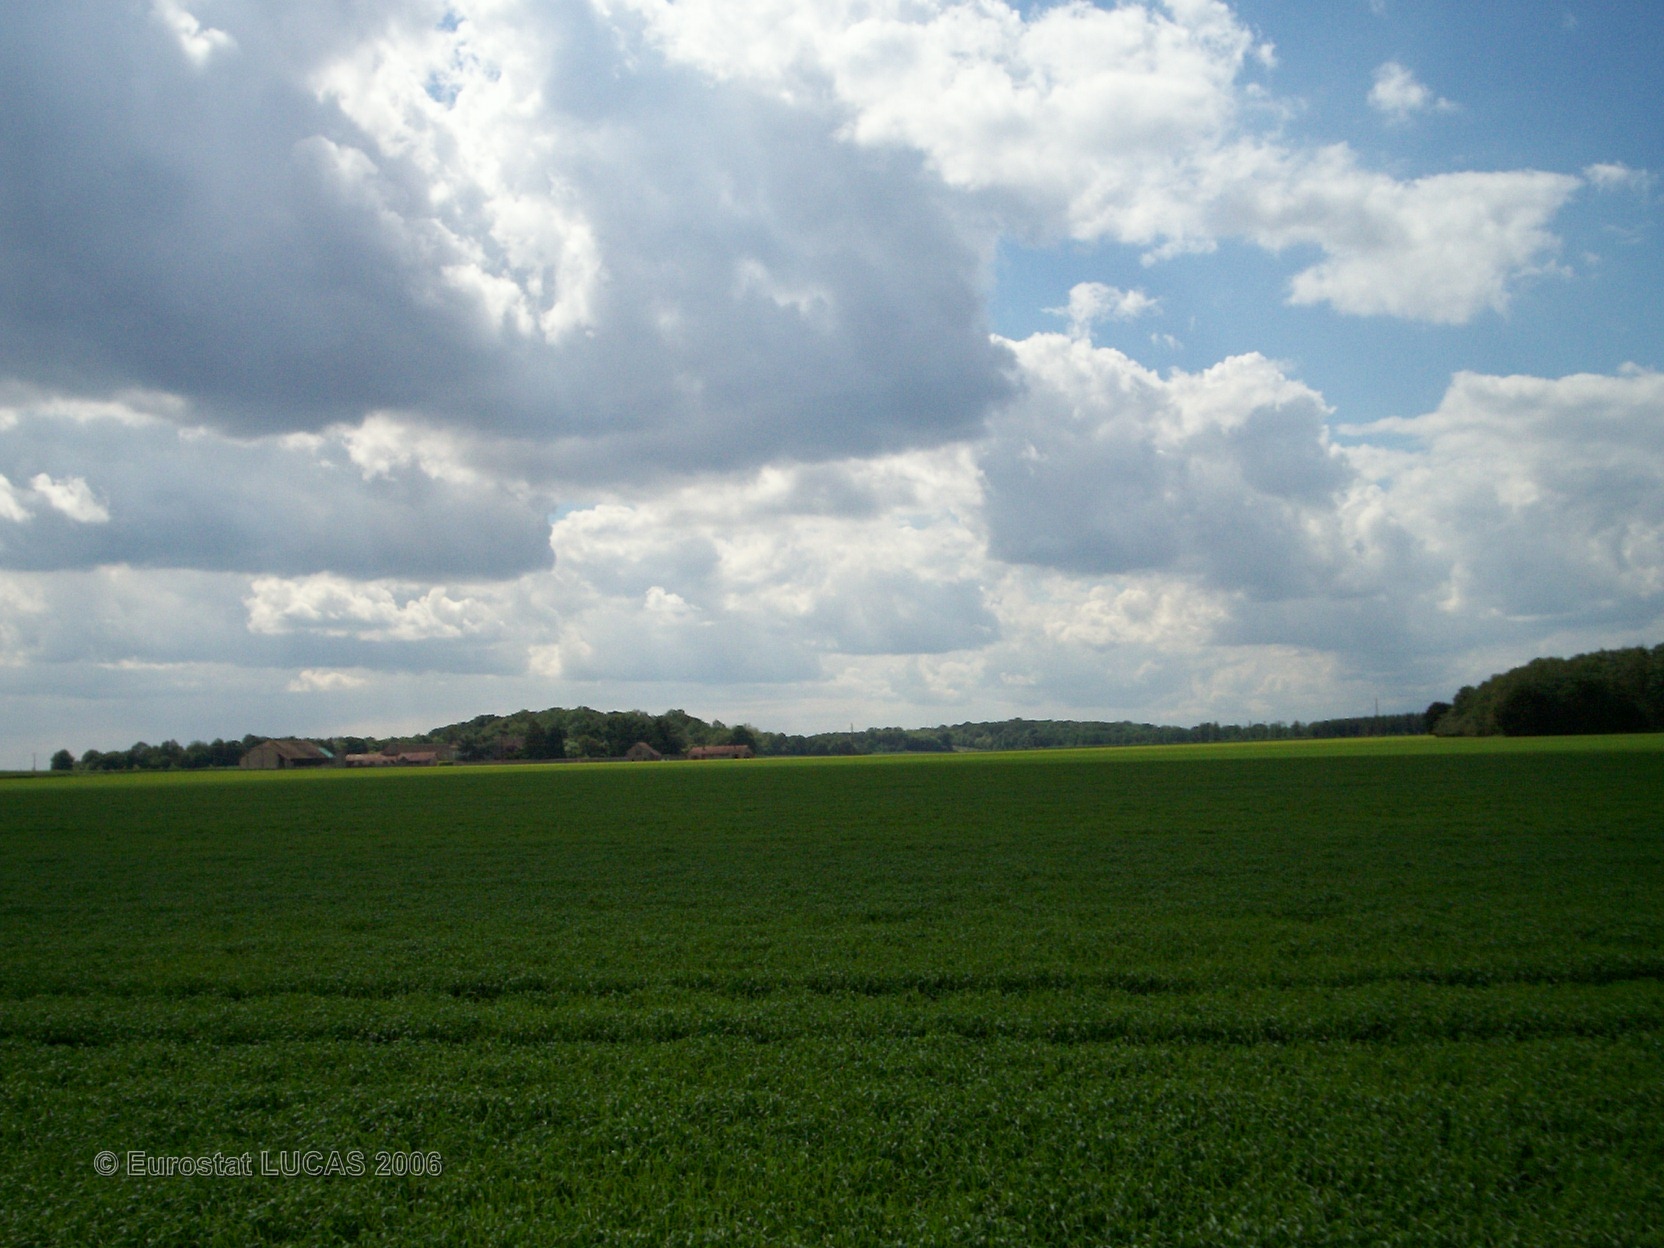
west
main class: Cropland
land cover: Barley
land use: Agriculture (excluding fallow land and kitchen gardens)
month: May
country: FR
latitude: 48.5443
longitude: 2.7437
